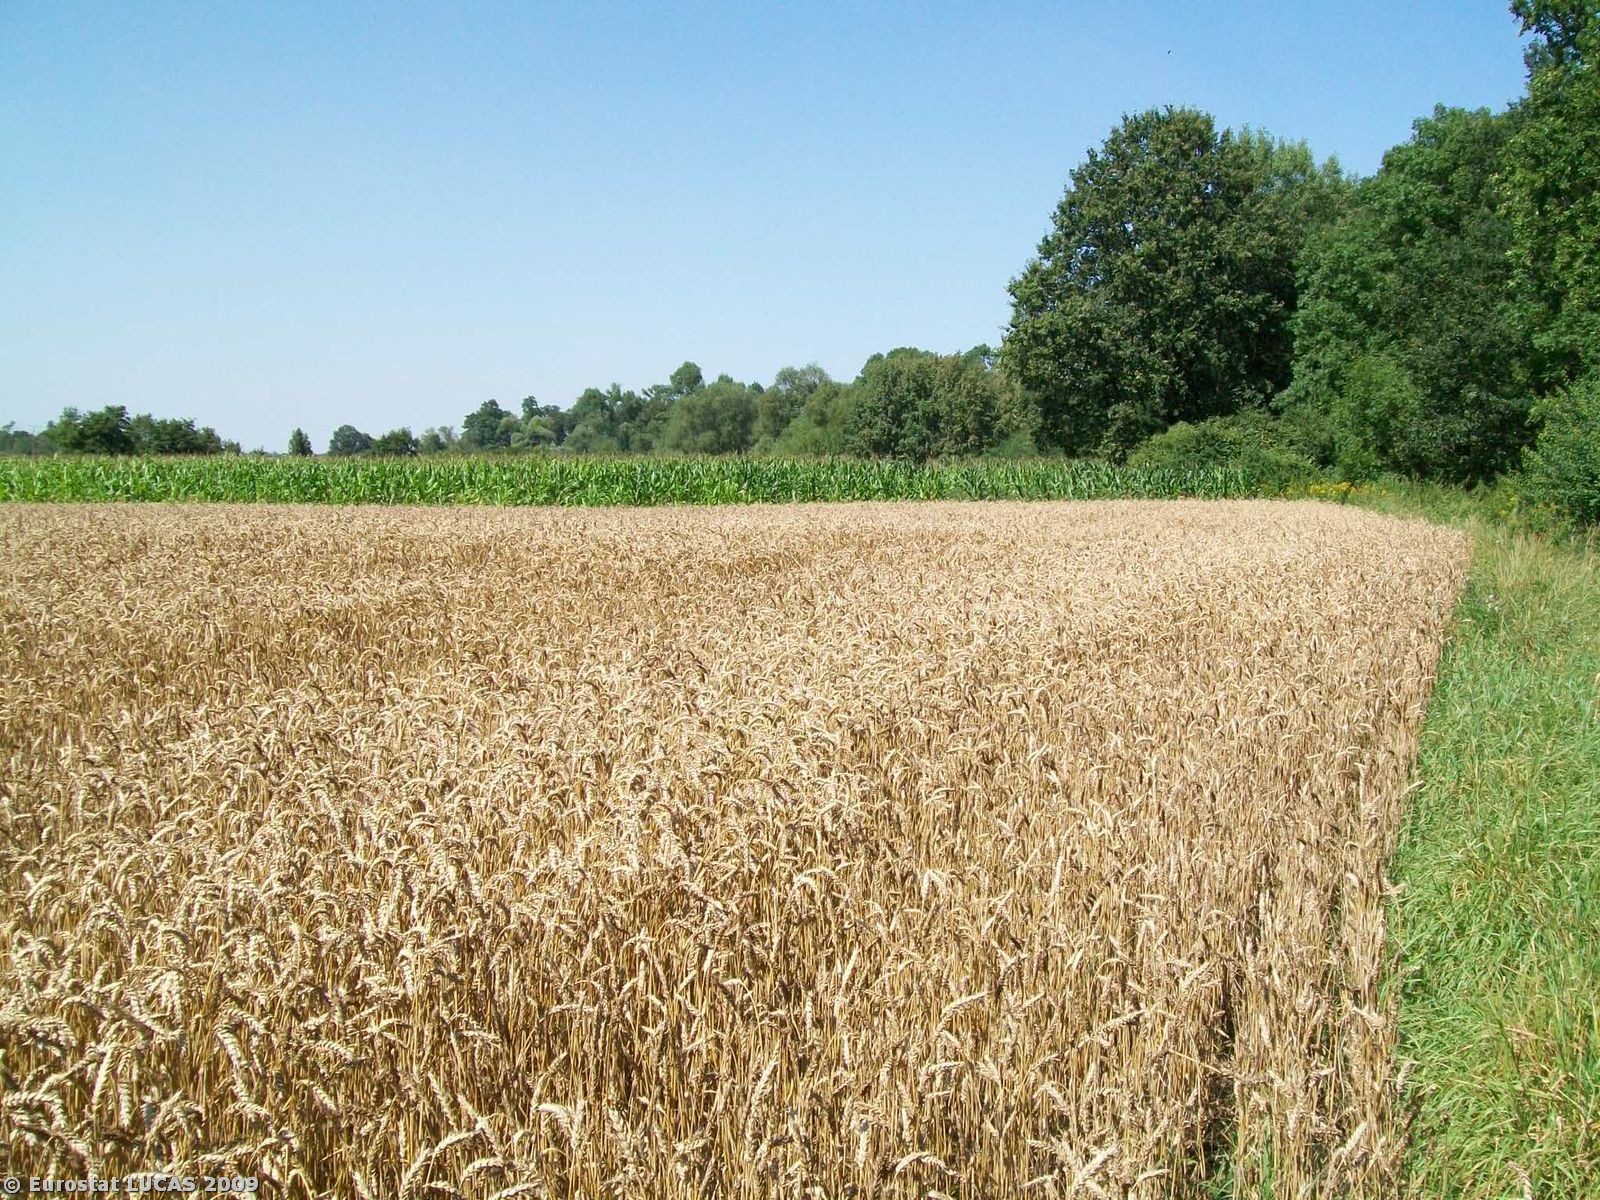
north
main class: Cropland
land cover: Common wheat
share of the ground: > 75 %
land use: Agriculture (excluding fallow land and kitchen gardens)
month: August
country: PL
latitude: 51.0484
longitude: 16.7561
